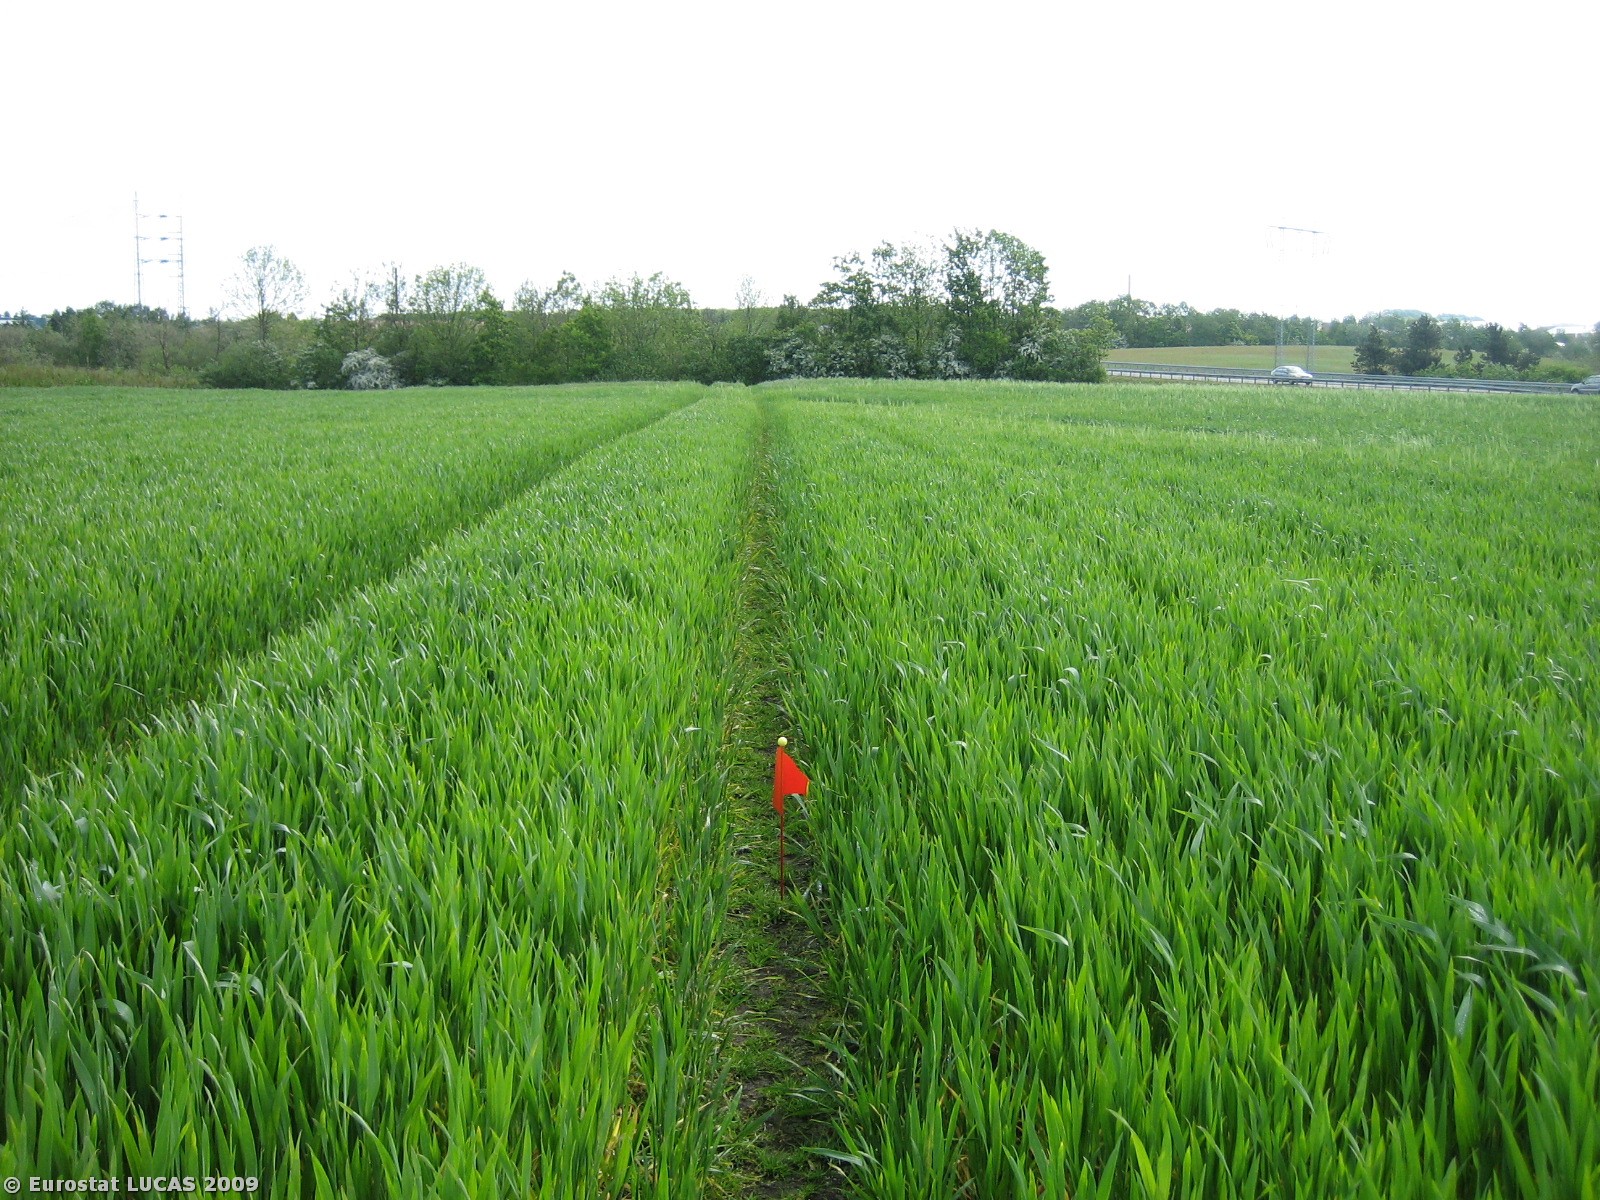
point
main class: Cropland
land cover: Barley
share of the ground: > 75 %
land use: Agriculture (excluding fallow land and kitchen gardens)
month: May
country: DK
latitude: 56.1293
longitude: 8.9233
